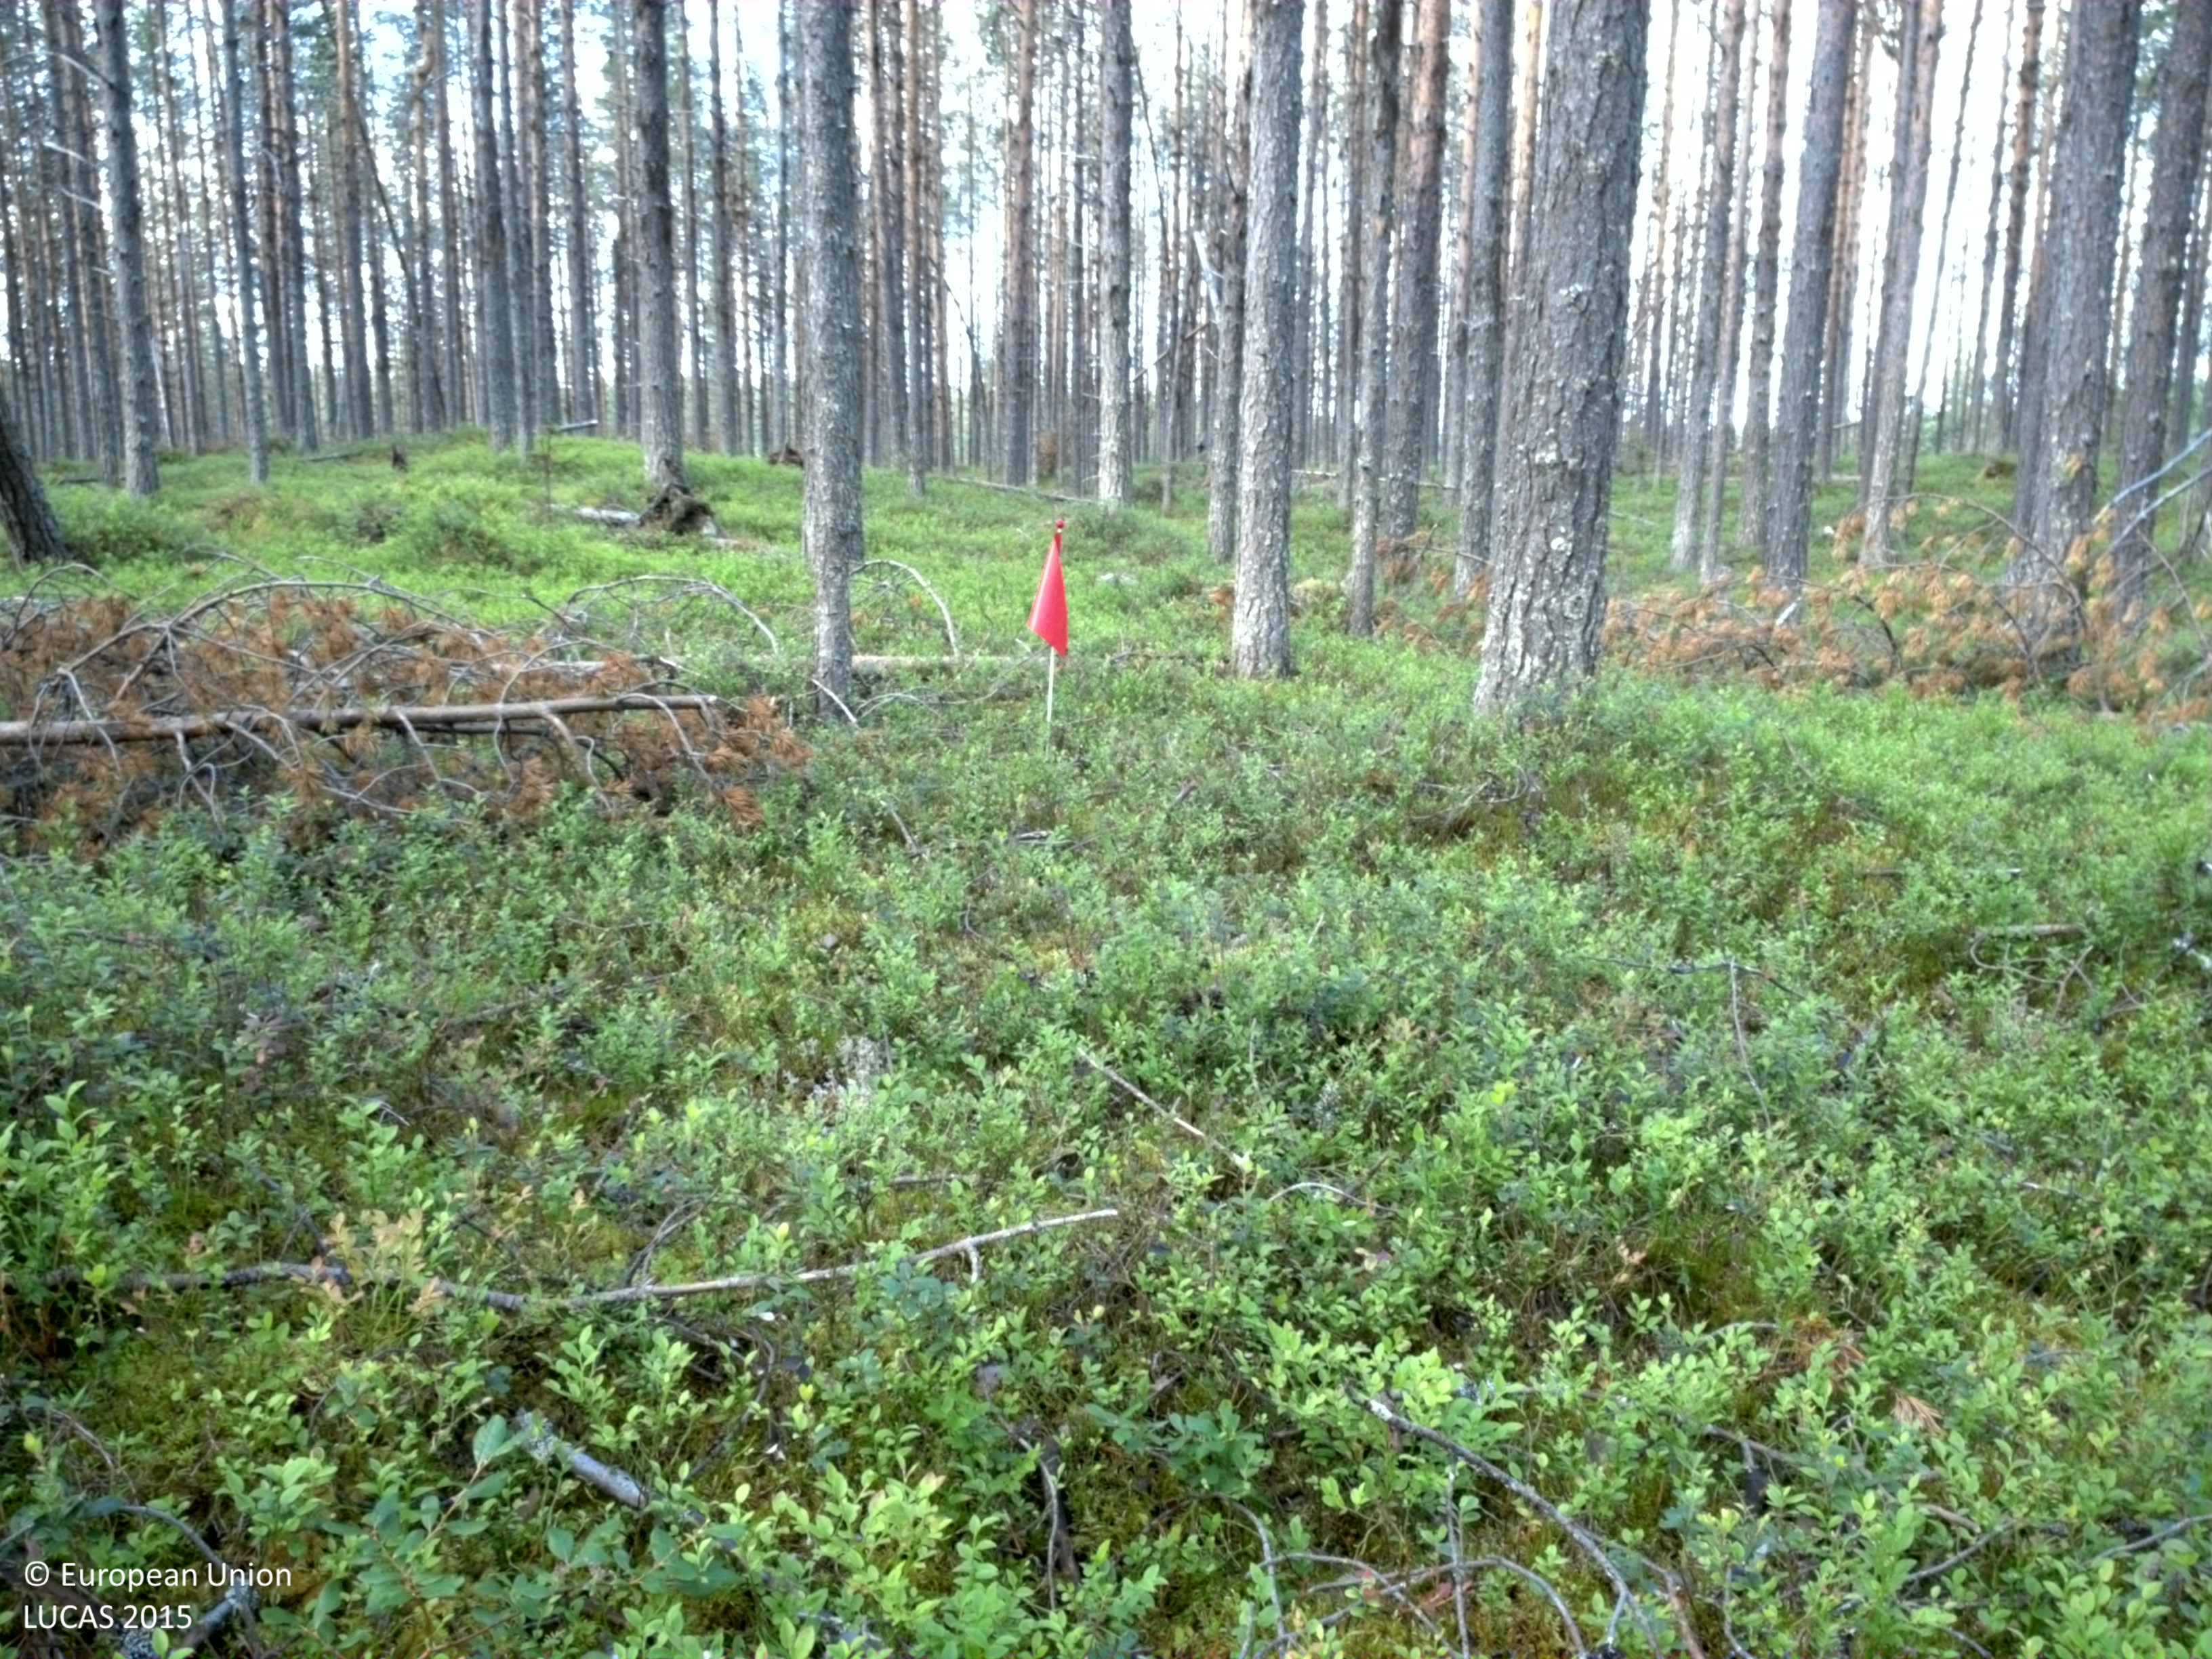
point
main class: Woodland
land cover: Pine dominated coniferous woodland
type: boreal forest
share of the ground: 25 - 50 %
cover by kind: shrubs 65 %, coniferous forest trees 35 %
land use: Forestry
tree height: > 5 m
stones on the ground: < 10 %
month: August
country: SE
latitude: 66.4988
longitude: 20.7671
